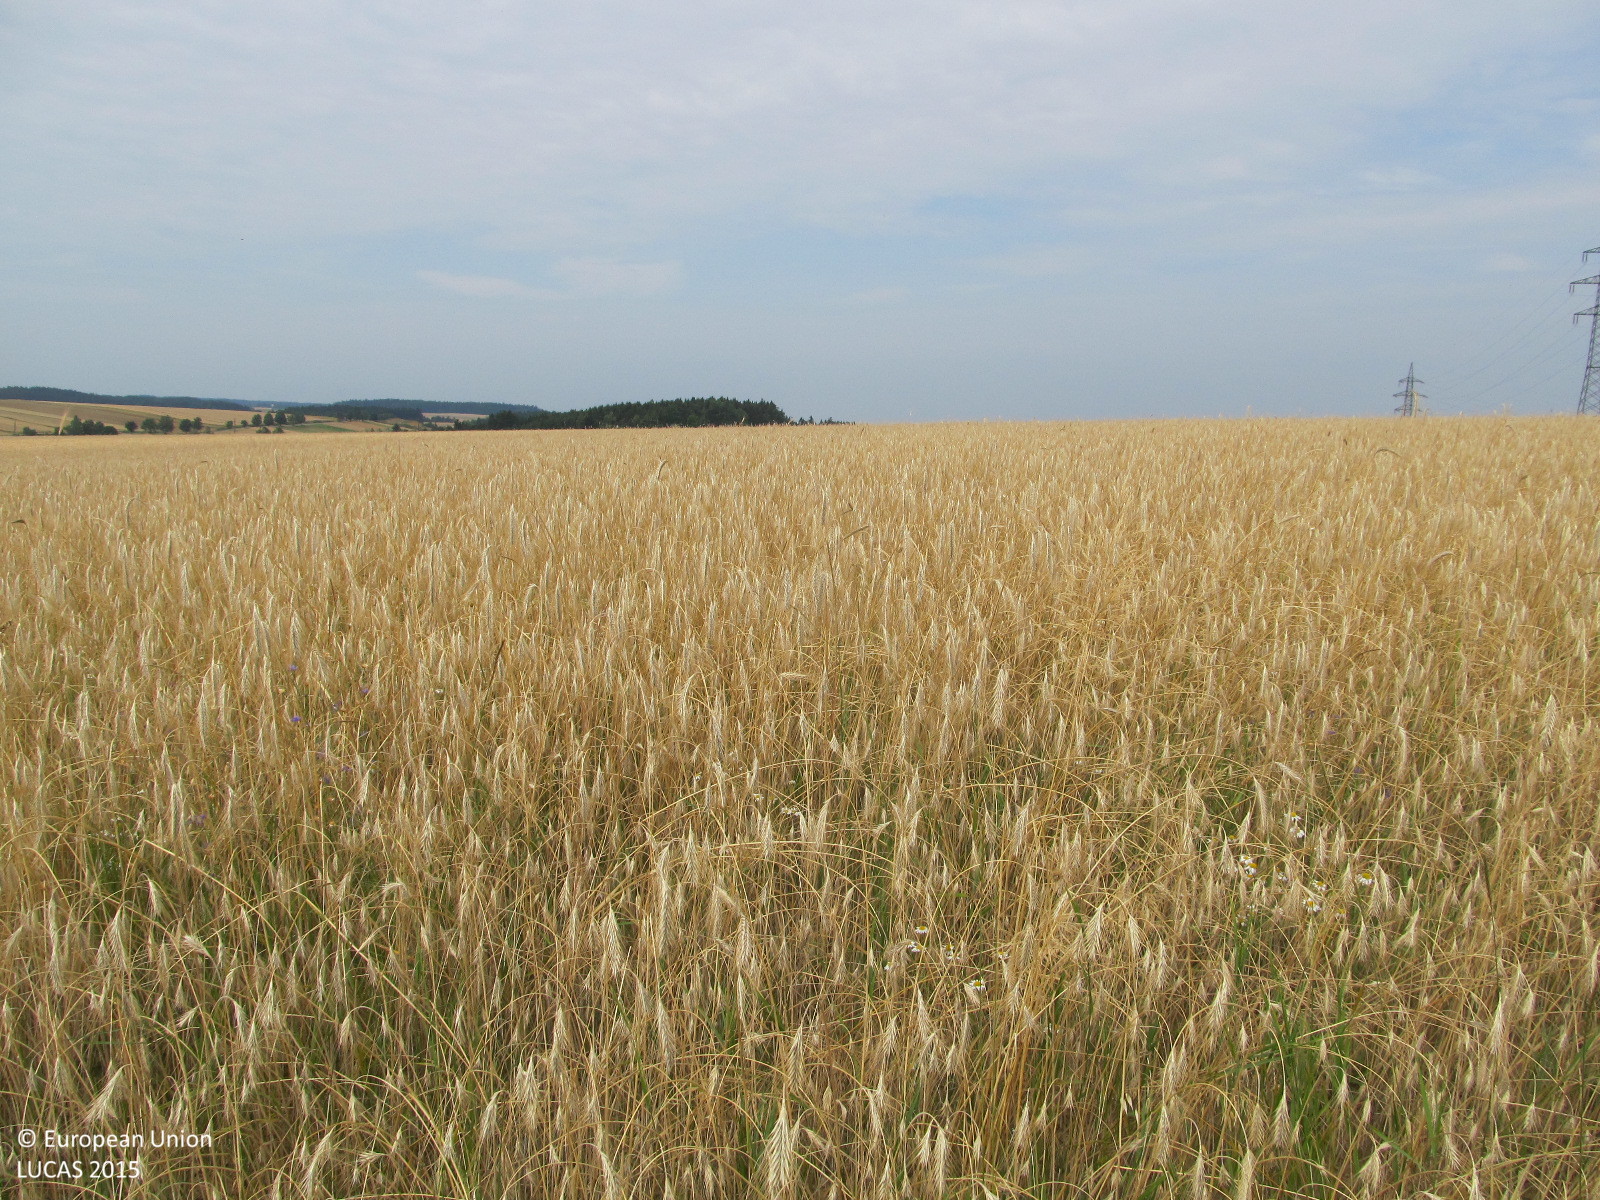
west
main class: Cropland
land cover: Barley
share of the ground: > 75 %
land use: Agriculture (excluding fallow land and kitchen gardens)
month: July
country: AT
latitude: 48.7430
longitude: 15.3470
